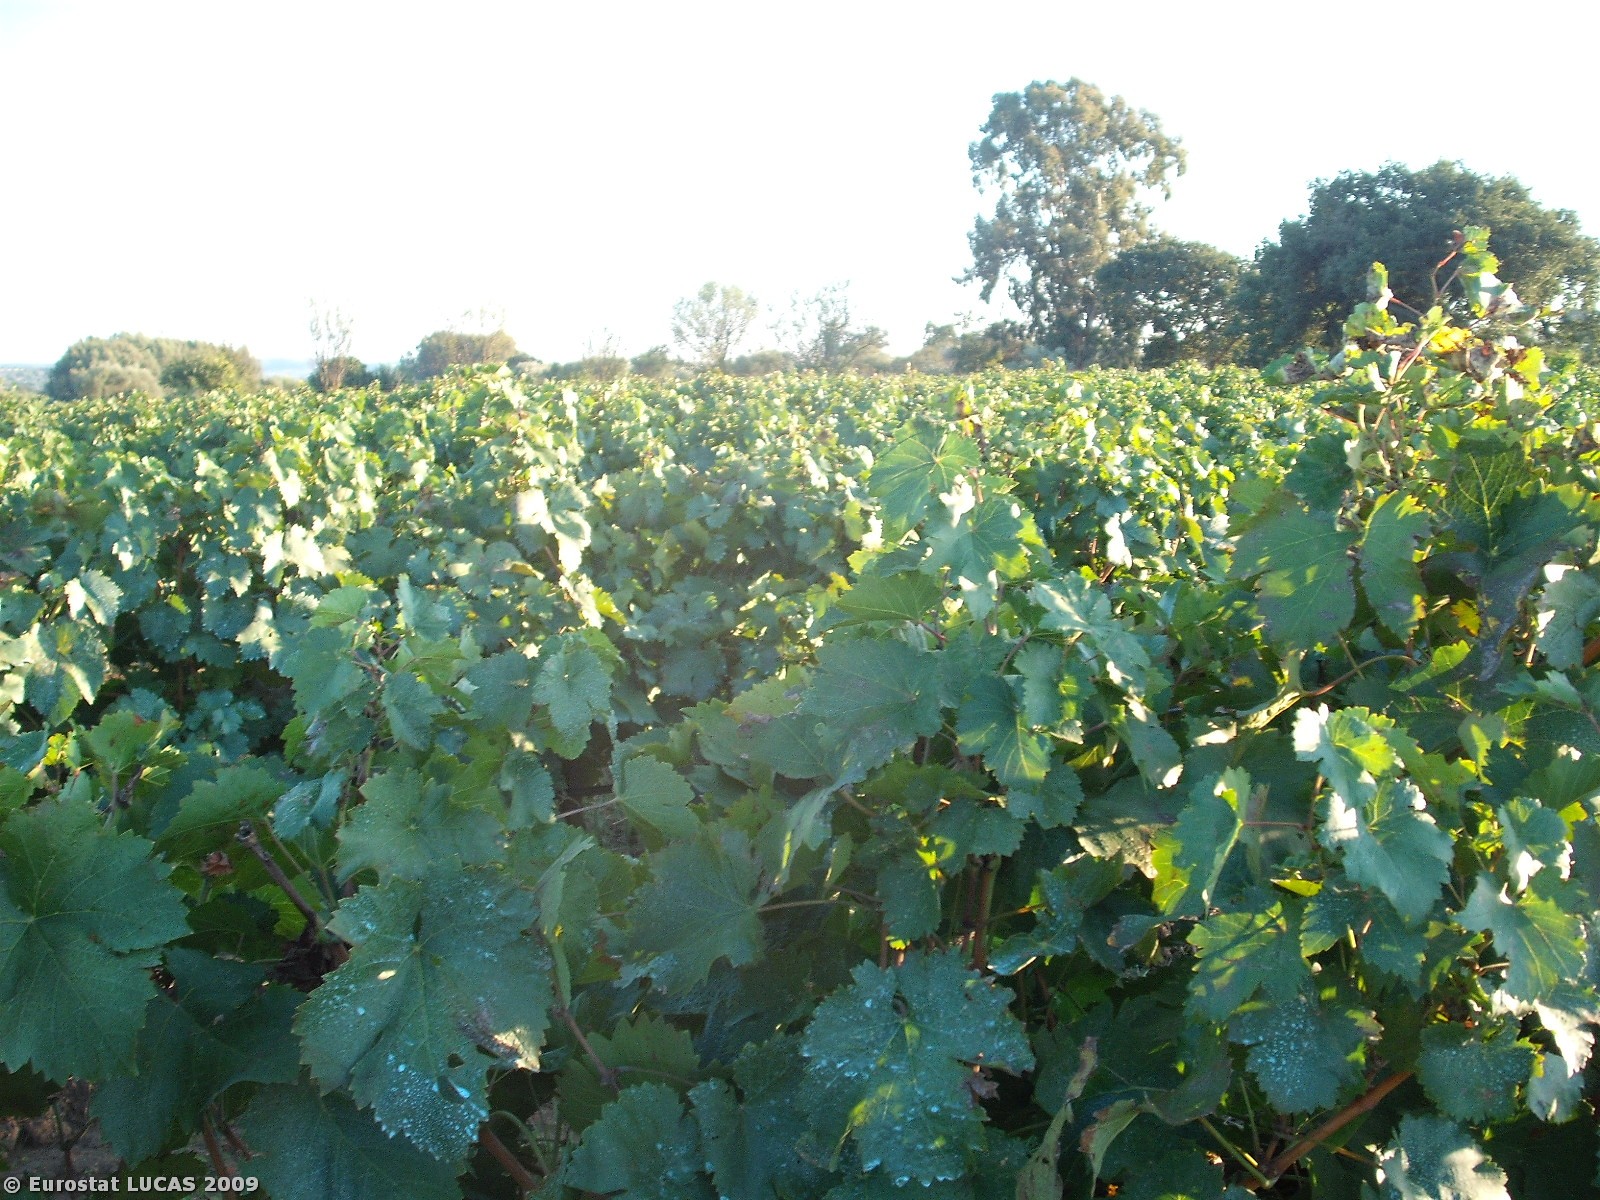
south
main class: Cropland
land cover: Vineyards
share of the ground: 25 - 50 %
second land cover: Grassland with sparse tree/shrub cover
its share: 50 - 75 %
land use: Agriculture (excluding fallow land and kitchen gardens)
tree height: < 5 m
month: October
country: GR
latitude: 38.0788
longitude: 21.4437
